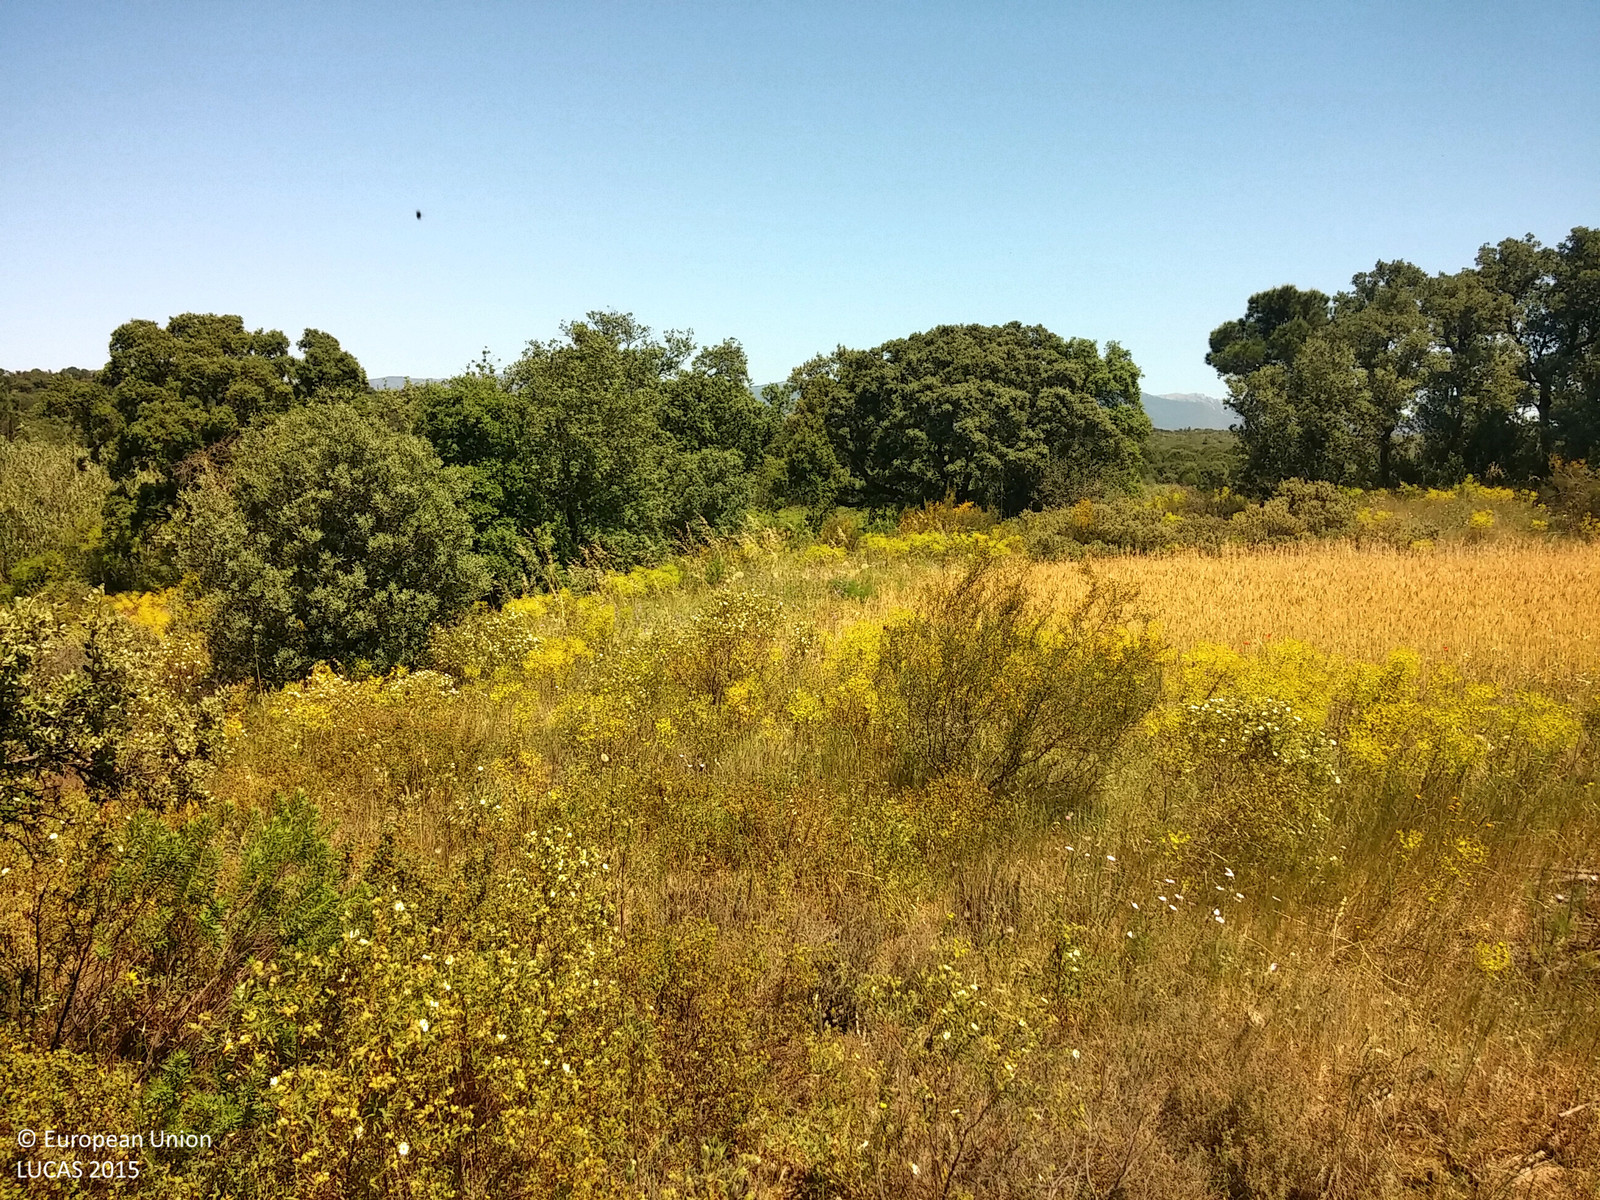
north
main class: Woodland
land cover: Broadleaved woodland
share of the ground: 25 - 50 %
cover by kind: herbaceous plants 55 %, broadleaved forest trees 35 %, shrubs 10 %
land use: Forestry
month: May
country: ES
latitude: 42.3545
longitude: 2.9602
